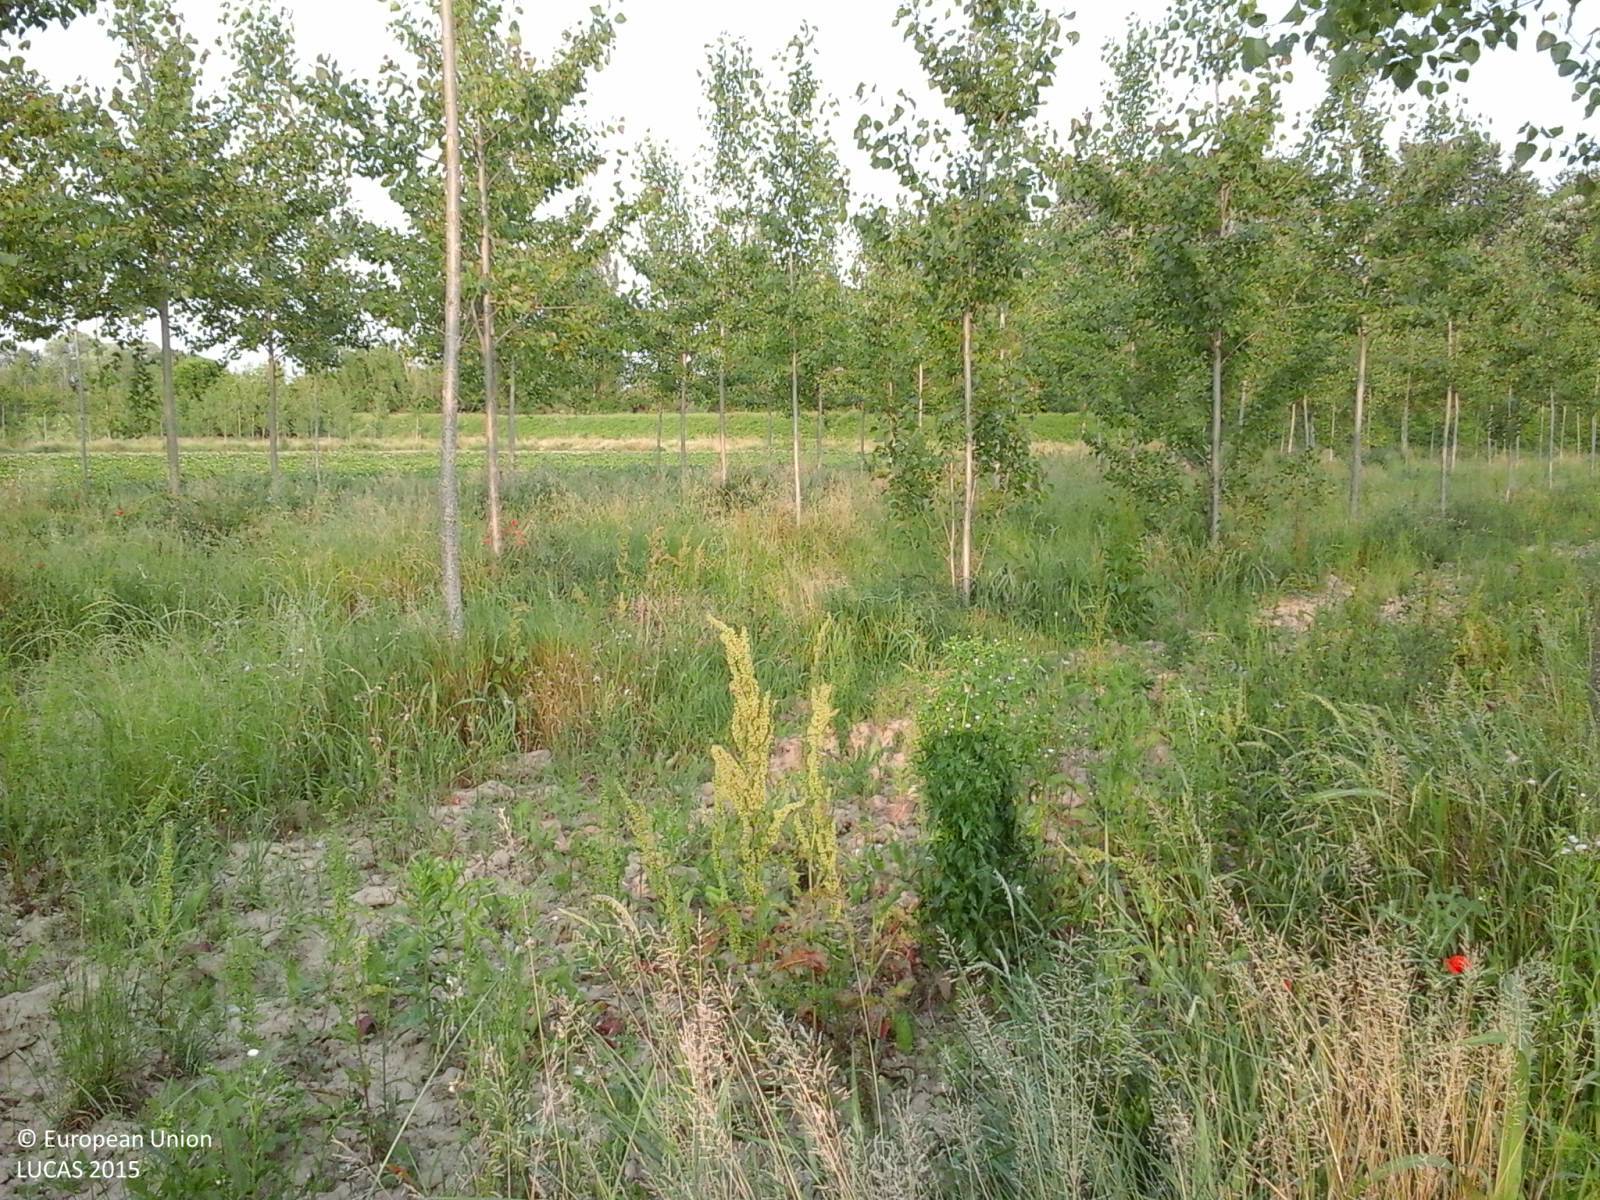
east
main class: Woodland
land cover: Broadleaved woodland
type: non-riverine alder, birch or aspen forest
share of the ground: > 75 %
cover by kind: broadleaved forest trees 70 %, herbaceous plants 20 %, unconsolidated bare surface 10 %
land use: Forestry
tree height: > 5 m
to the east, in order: Broadleaved woodland; Other fresh vegetables; Soya; Broadleaved woodland; Grass margins; Paved roads, cycling and walking lanes; Grassland without tree/shrub cover; Broadleaved woodland
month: June
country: IT
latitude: 45.8454
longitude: 13.4341
